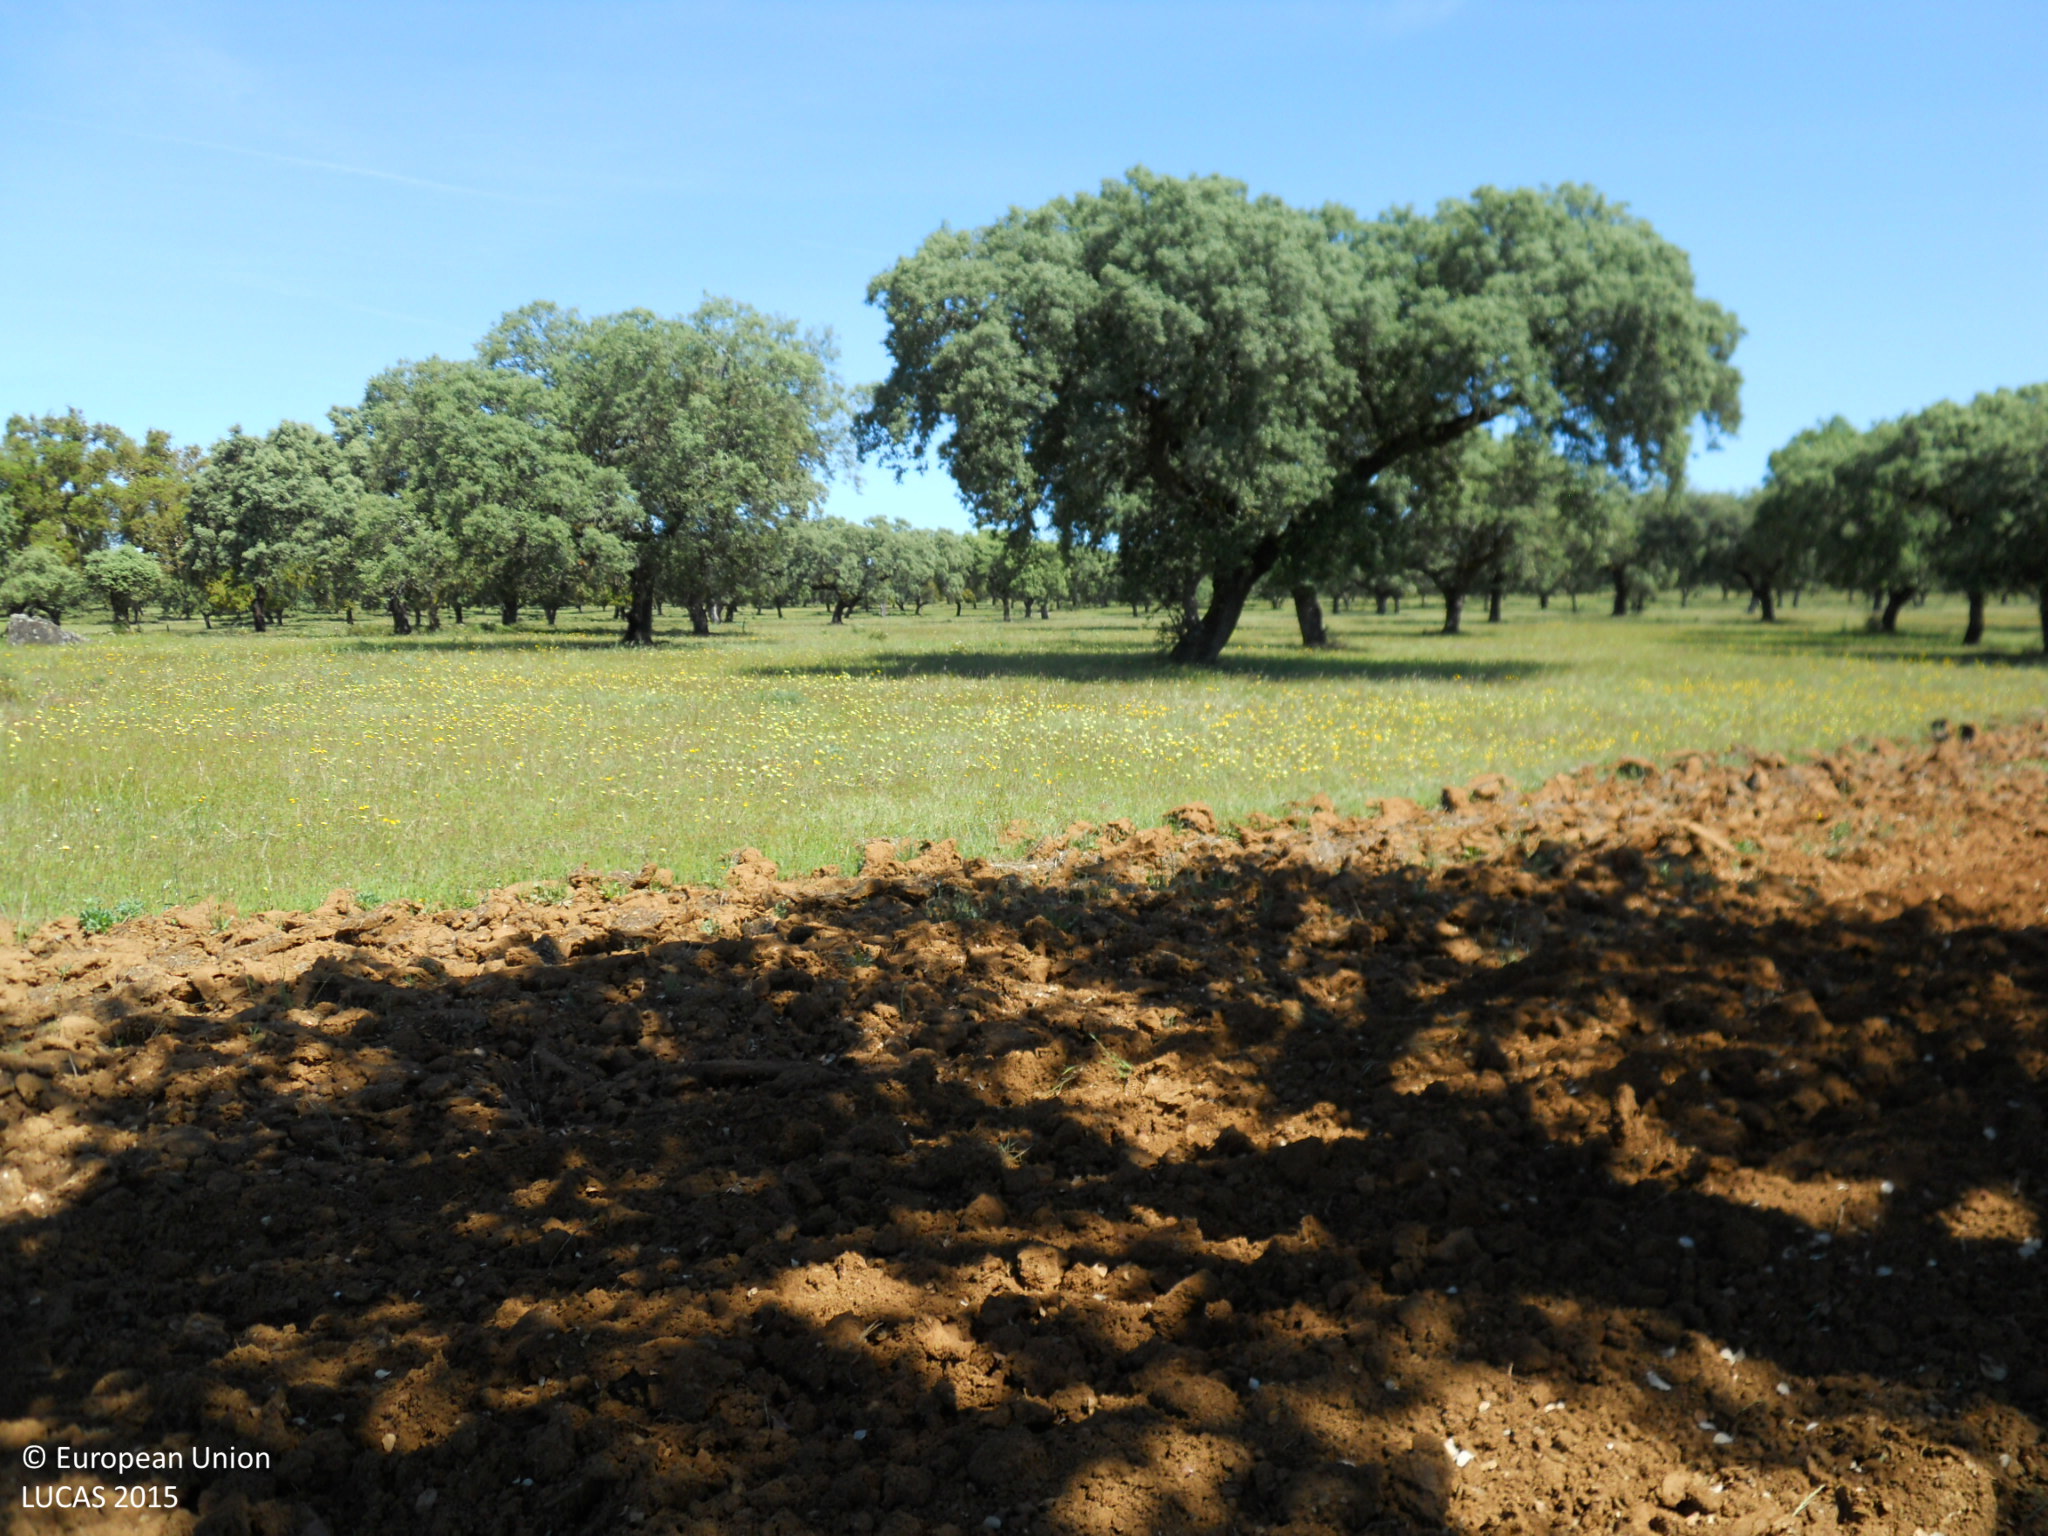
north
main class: Woodland
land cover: Broadleaved woodland
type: broadleaved evergreen forest
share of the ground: > 75 %
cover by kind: broadleaved forest trees 90 %, herbaceous plants 5 %, unconsolidated bare surface 5 %
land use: Forestry
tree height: > 5 m
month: April
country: ES
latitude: 39.1623
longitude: -6.7708
